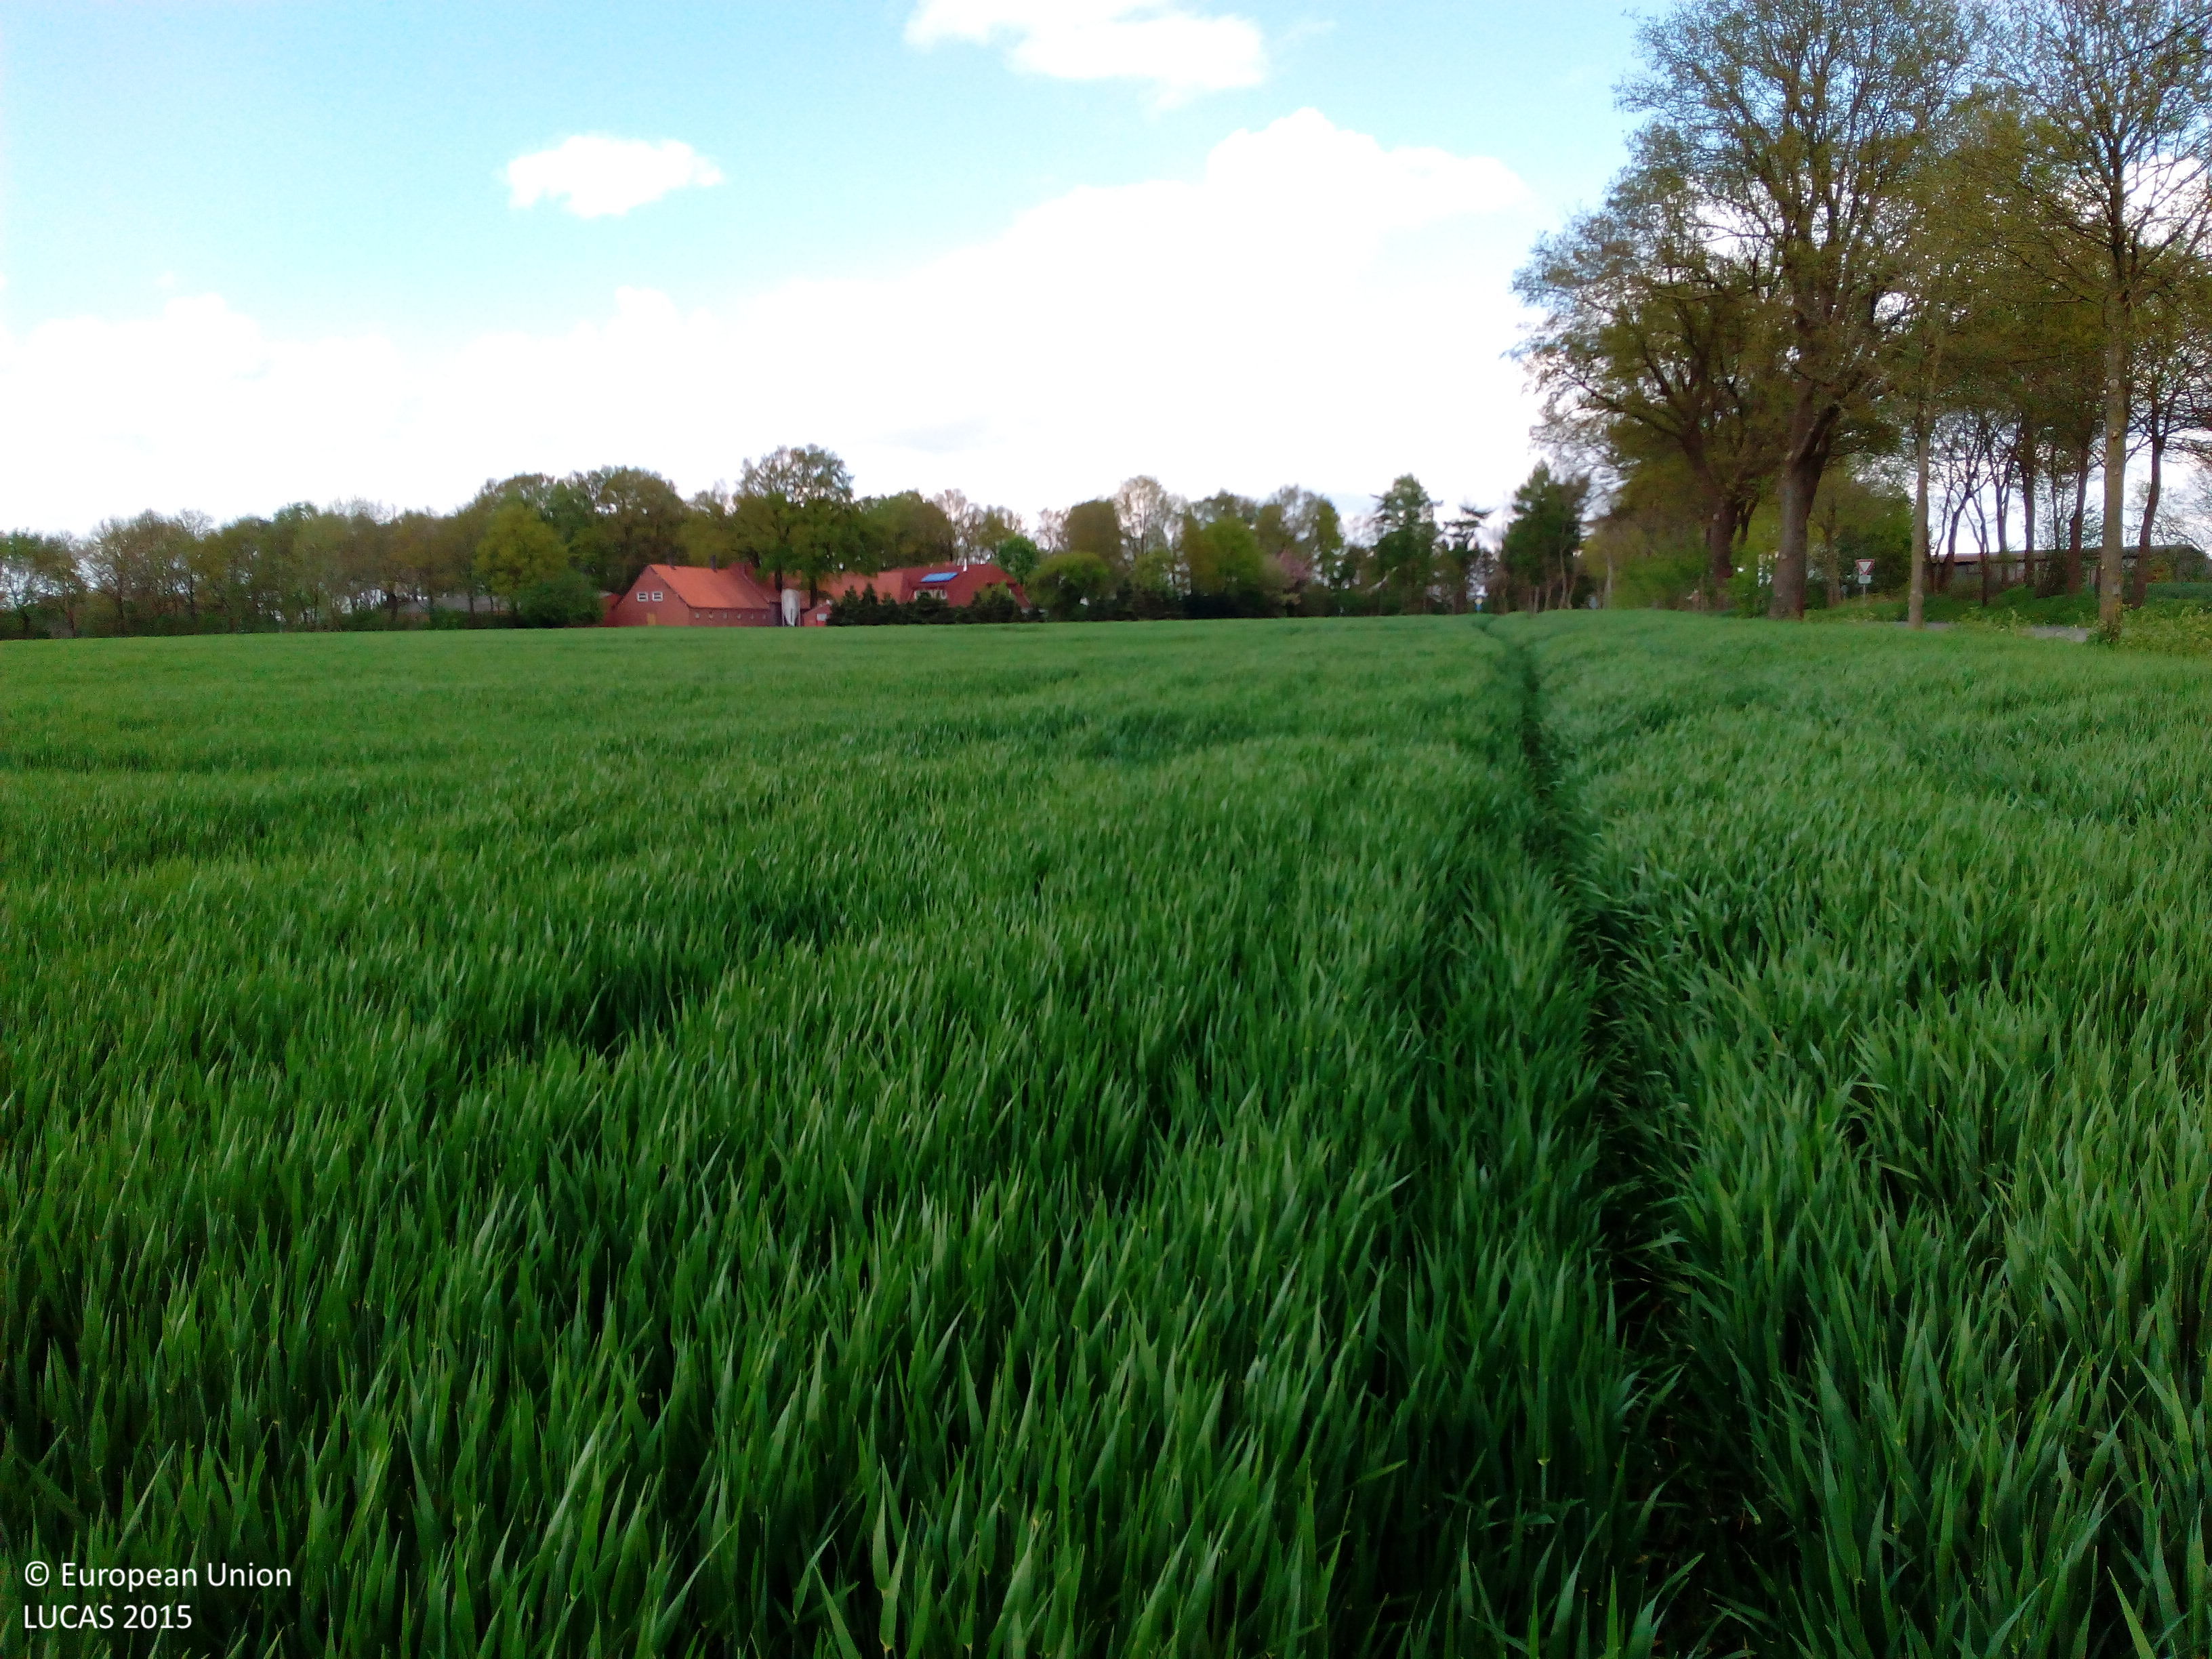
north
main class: Cropland
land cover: Barley
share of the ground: > 75 %
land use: Agriculture (excluding fallow land and kitchen gardens)
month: May
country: DE
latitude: 52.8640
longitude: 7.9953
